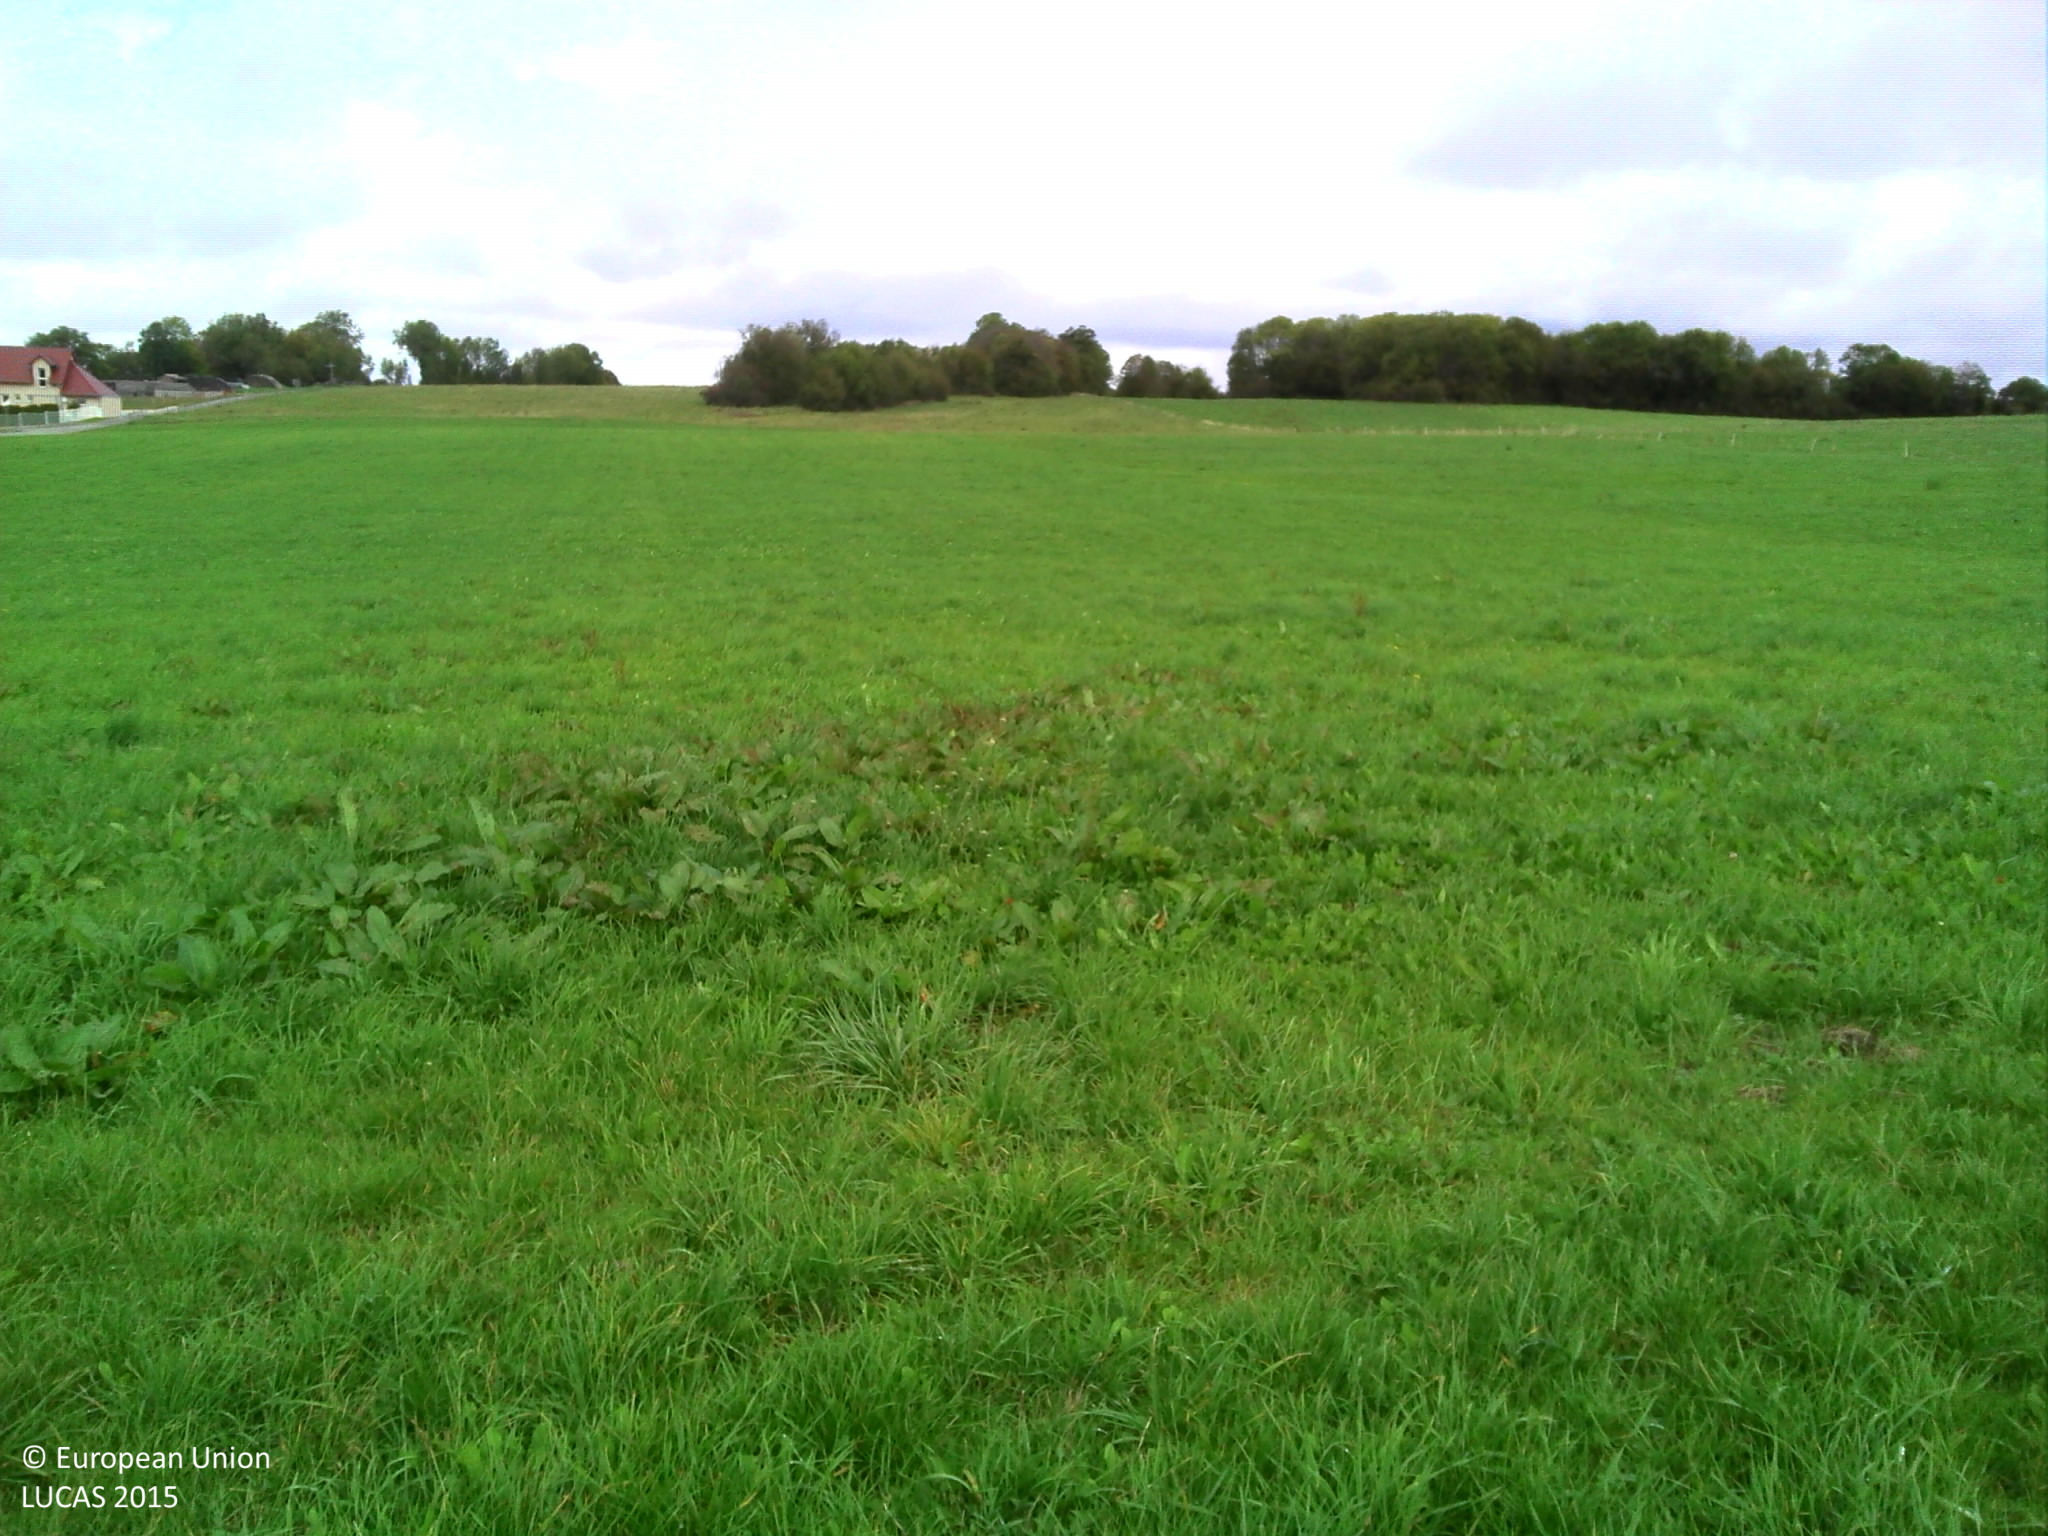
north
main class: Grassland
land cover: Grassland without tree/shrub cover
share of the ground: > 75 %
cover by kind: herbaceous plants 100 %
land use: Agriculture (excluding fallow land and kitchen gardens)
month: October
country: FR
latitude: 47.0541
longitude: 6.0659
